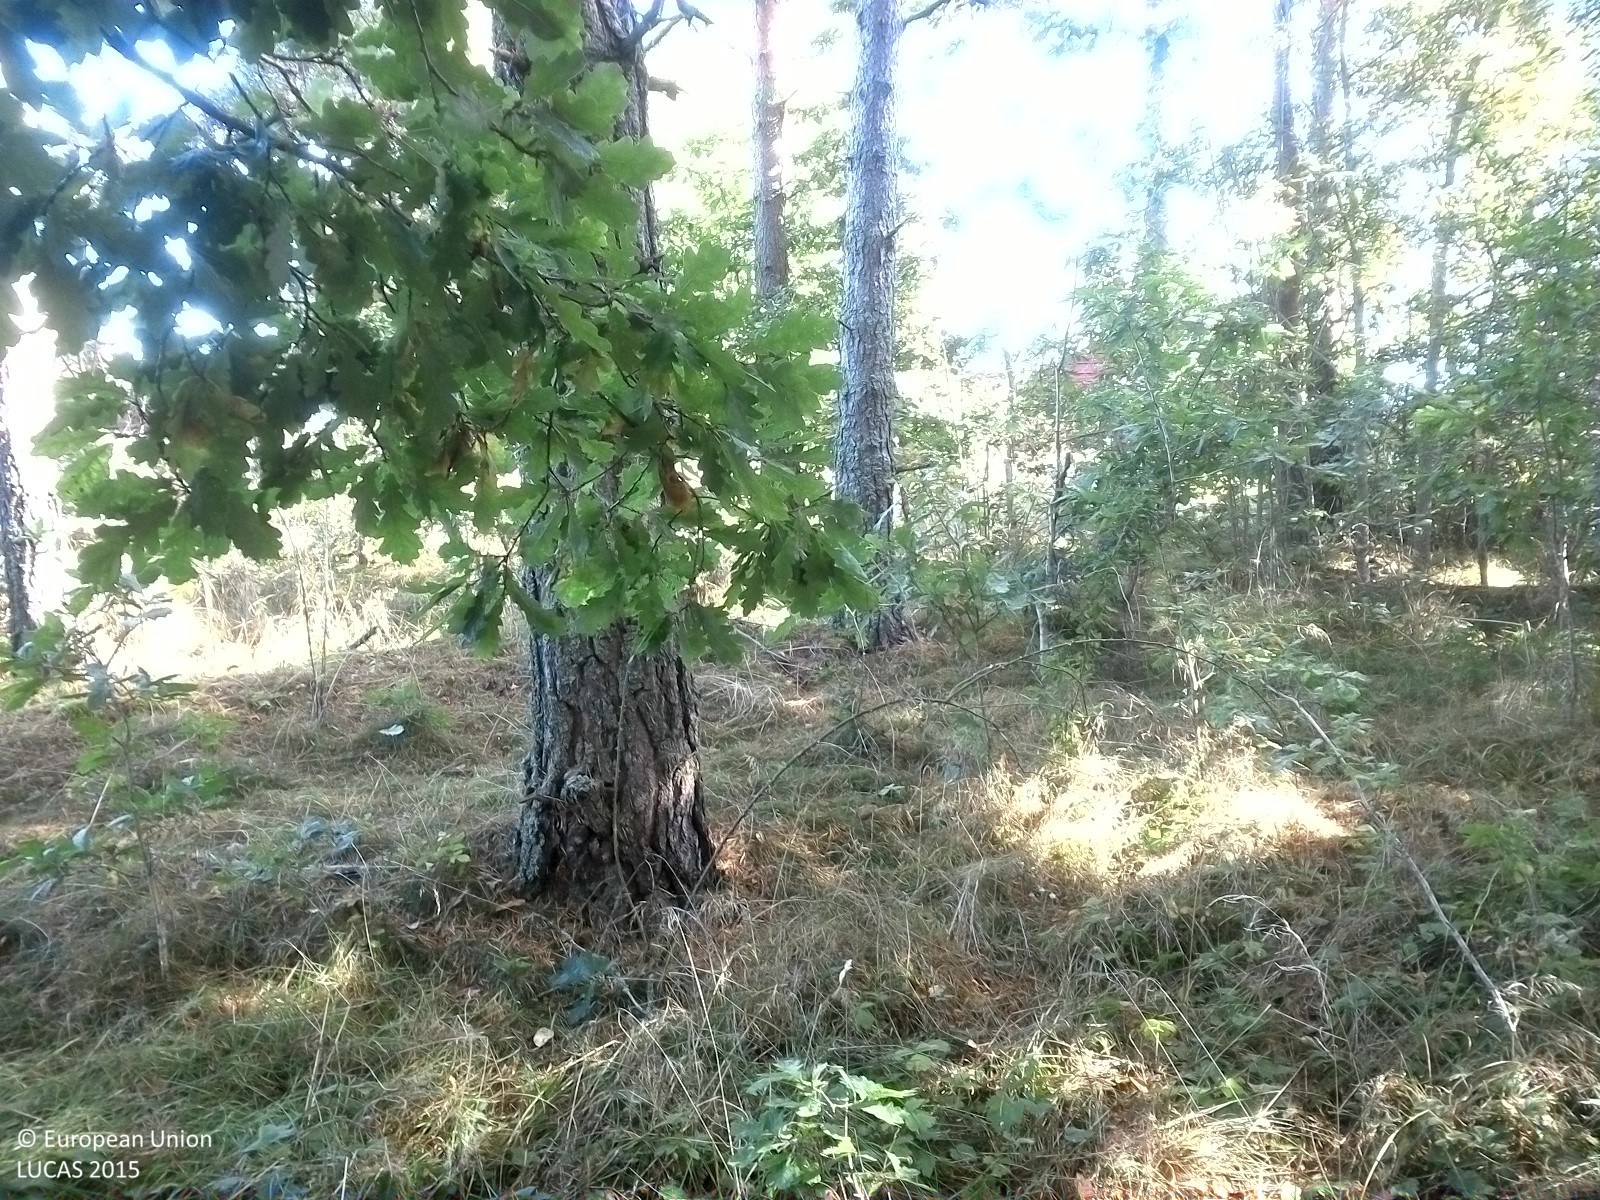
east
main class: Woodland
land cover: Pine dominated mixed woodland
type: boreal forest
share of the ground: 25 - 50 %
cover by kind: herbaceous plants 45 %, coniferous forest trees 25 %, broadleaved forest trees 20 %, shrubs 5 %, lichens and mosses 5 %
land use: Forestry
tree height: > 5 m
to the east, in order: Pine dominated mixed woodland; Pine dominated coniferous woodland; Electric lines; Paved roads, cycling and walking lanes; Shrubland without tree cover
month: September
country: SE
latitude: 58.4932
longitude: 16.9112
